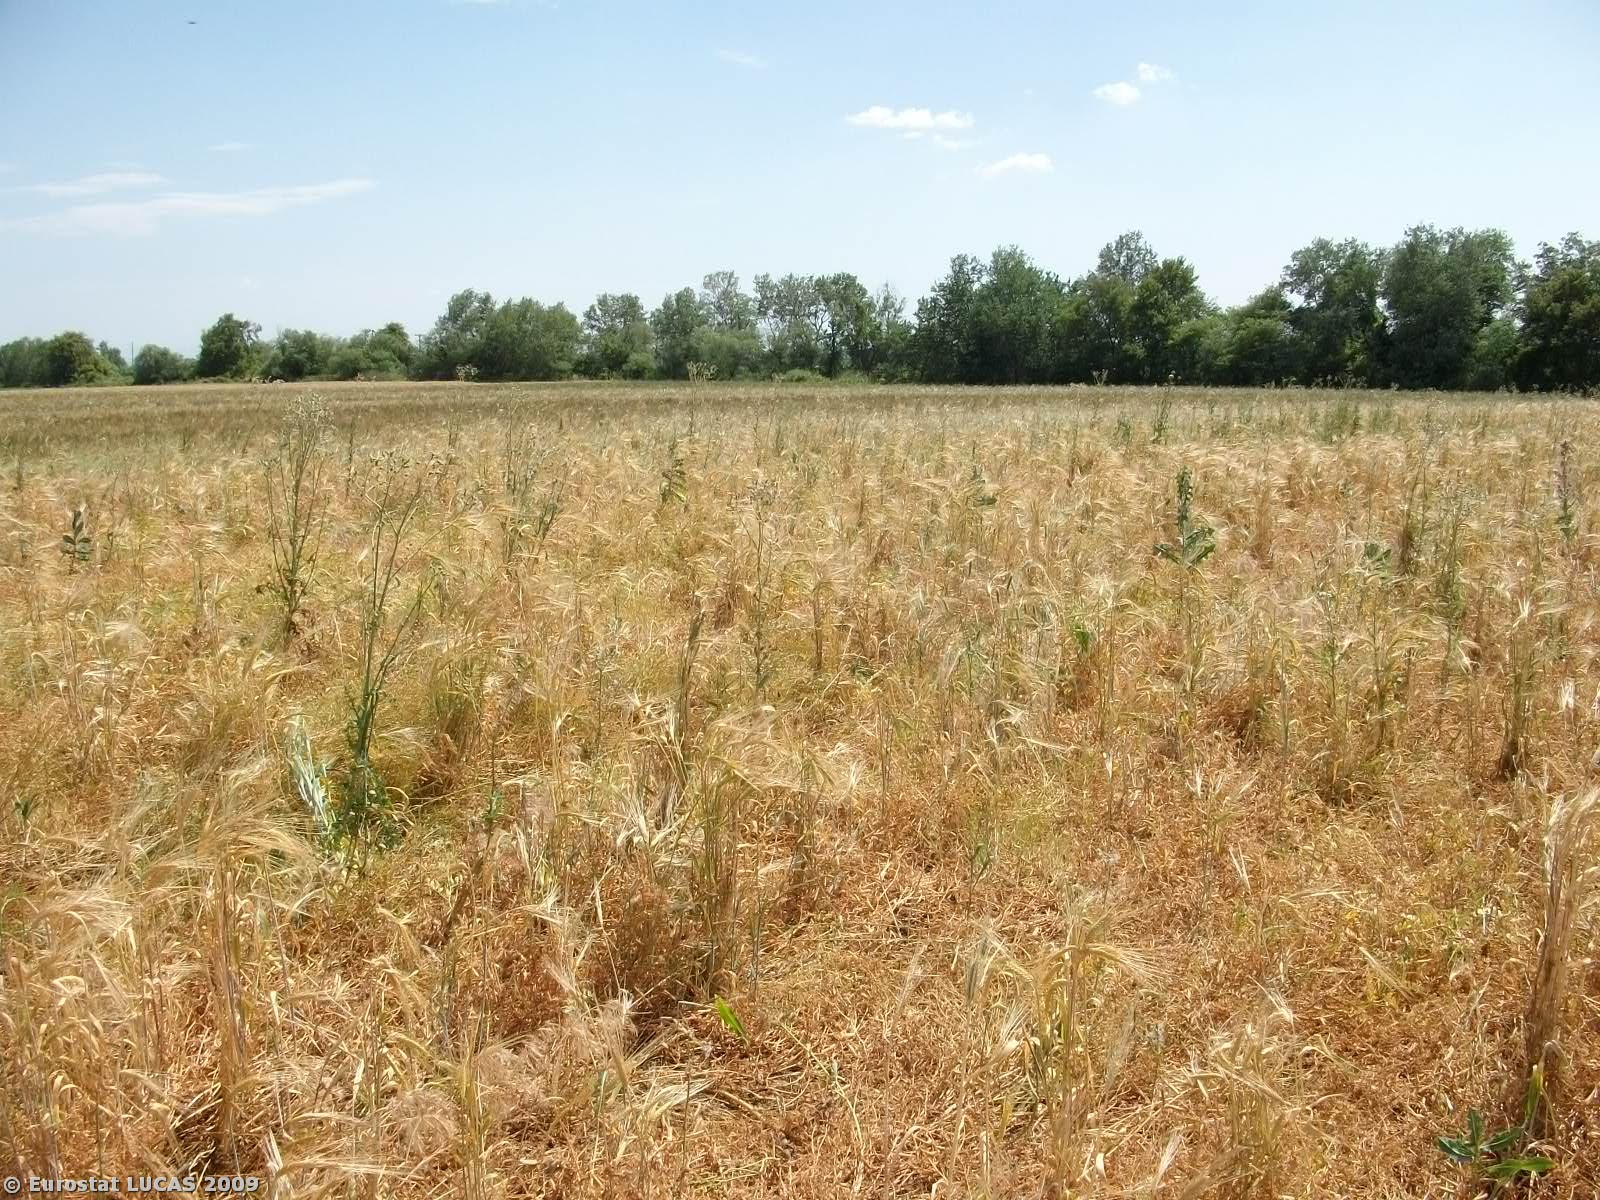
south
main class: Cropland
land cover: Durum wheat
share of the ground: 25 - 50 %
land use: Agriculture (excluding fallow land and kitchen gardens)
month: May
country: GR
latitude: 39.7669
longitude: 22.4239
